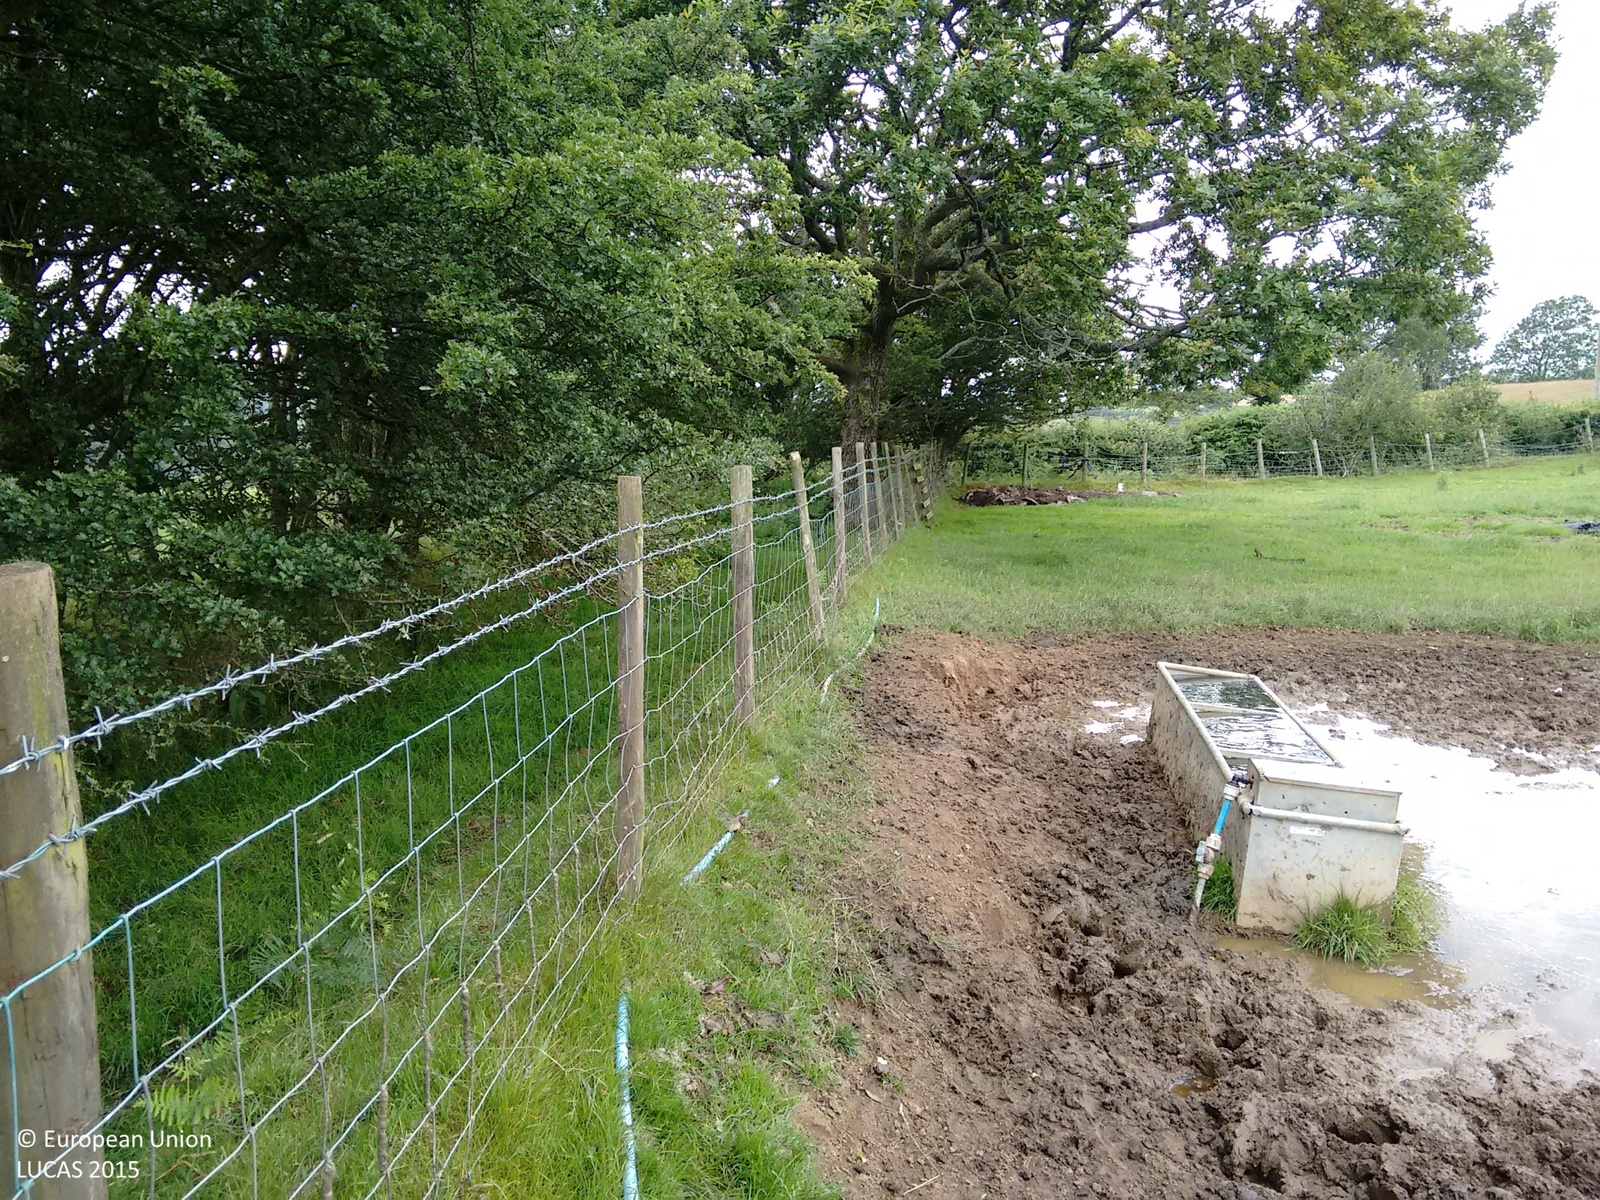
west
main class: Grassland
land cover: Grassland without tree/shrub cover
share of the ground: > 75 %
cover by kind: herbaceous plants 100 %
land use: Agriculture (excluding fallow land and kitchen gardens)
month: July
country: GB
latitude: 51.5568
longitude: -3.5718
